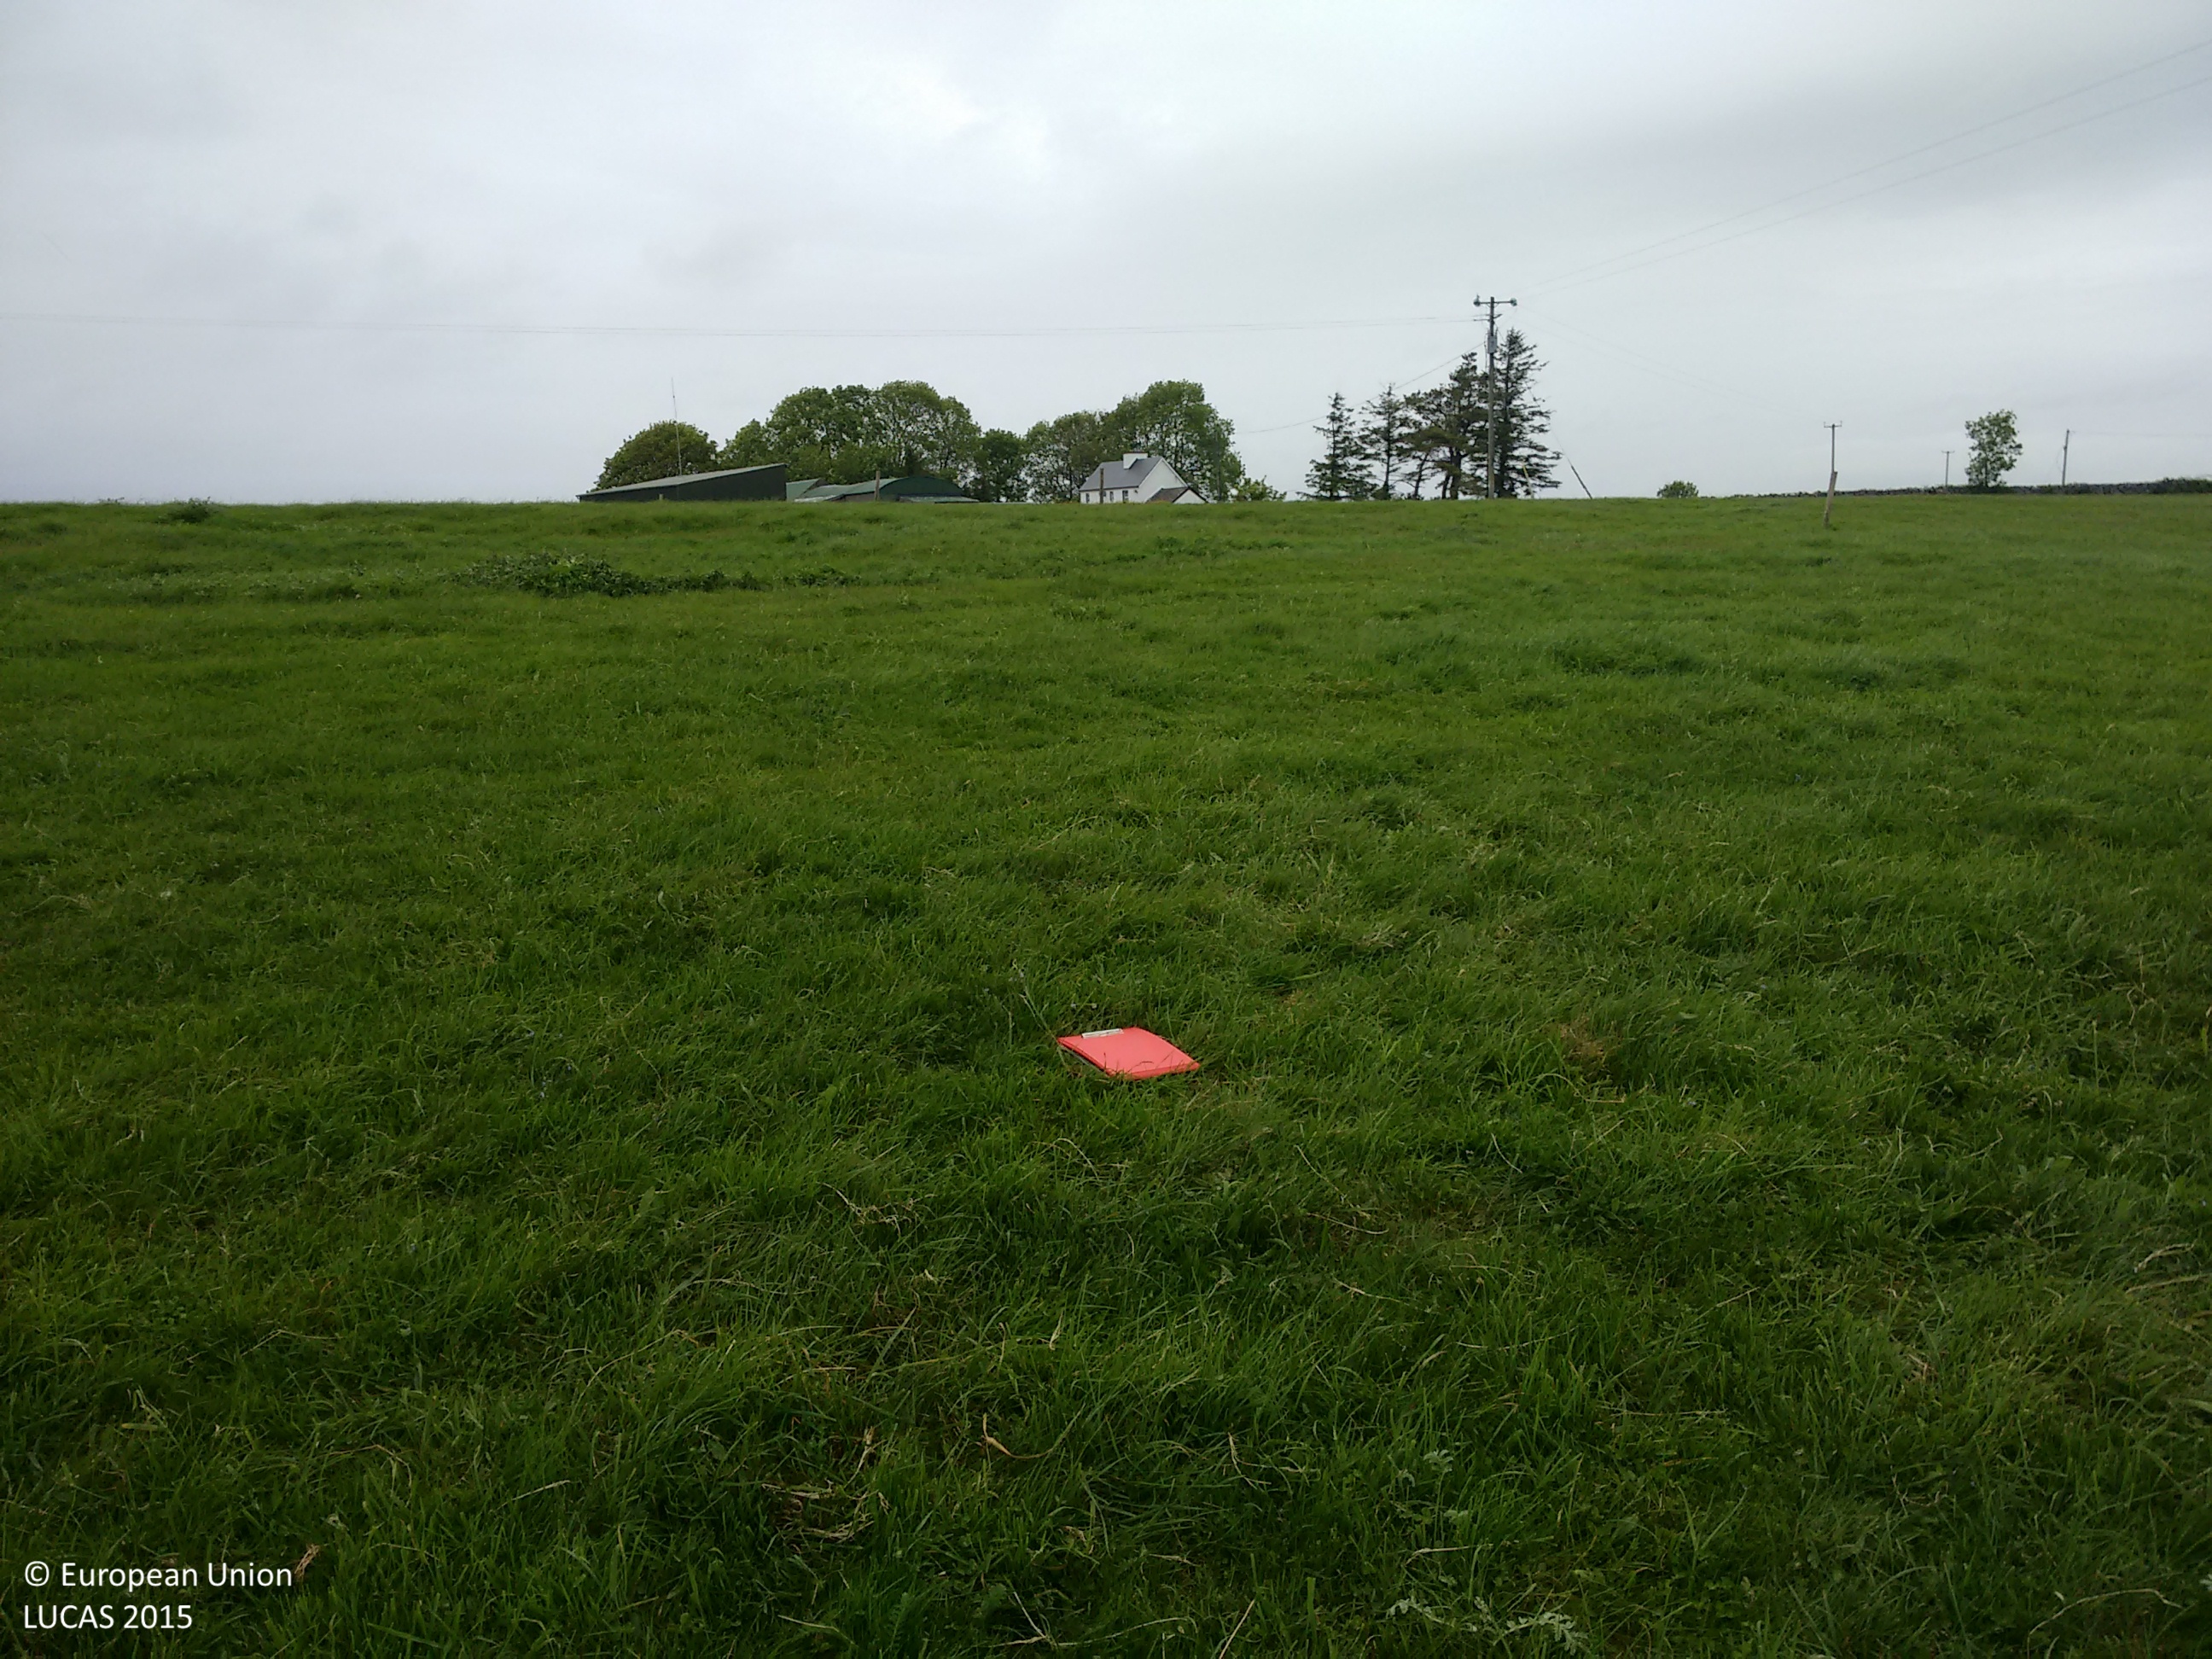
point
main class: Grassland
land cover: Grassland without tree/shrub cover
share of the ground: > 75 %
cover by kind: herbaceous plants 100 %
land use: Agriculture (excluding fallow land and kitchen gardens)
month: May
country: IE
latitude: 53.1407
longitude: -8.8486
